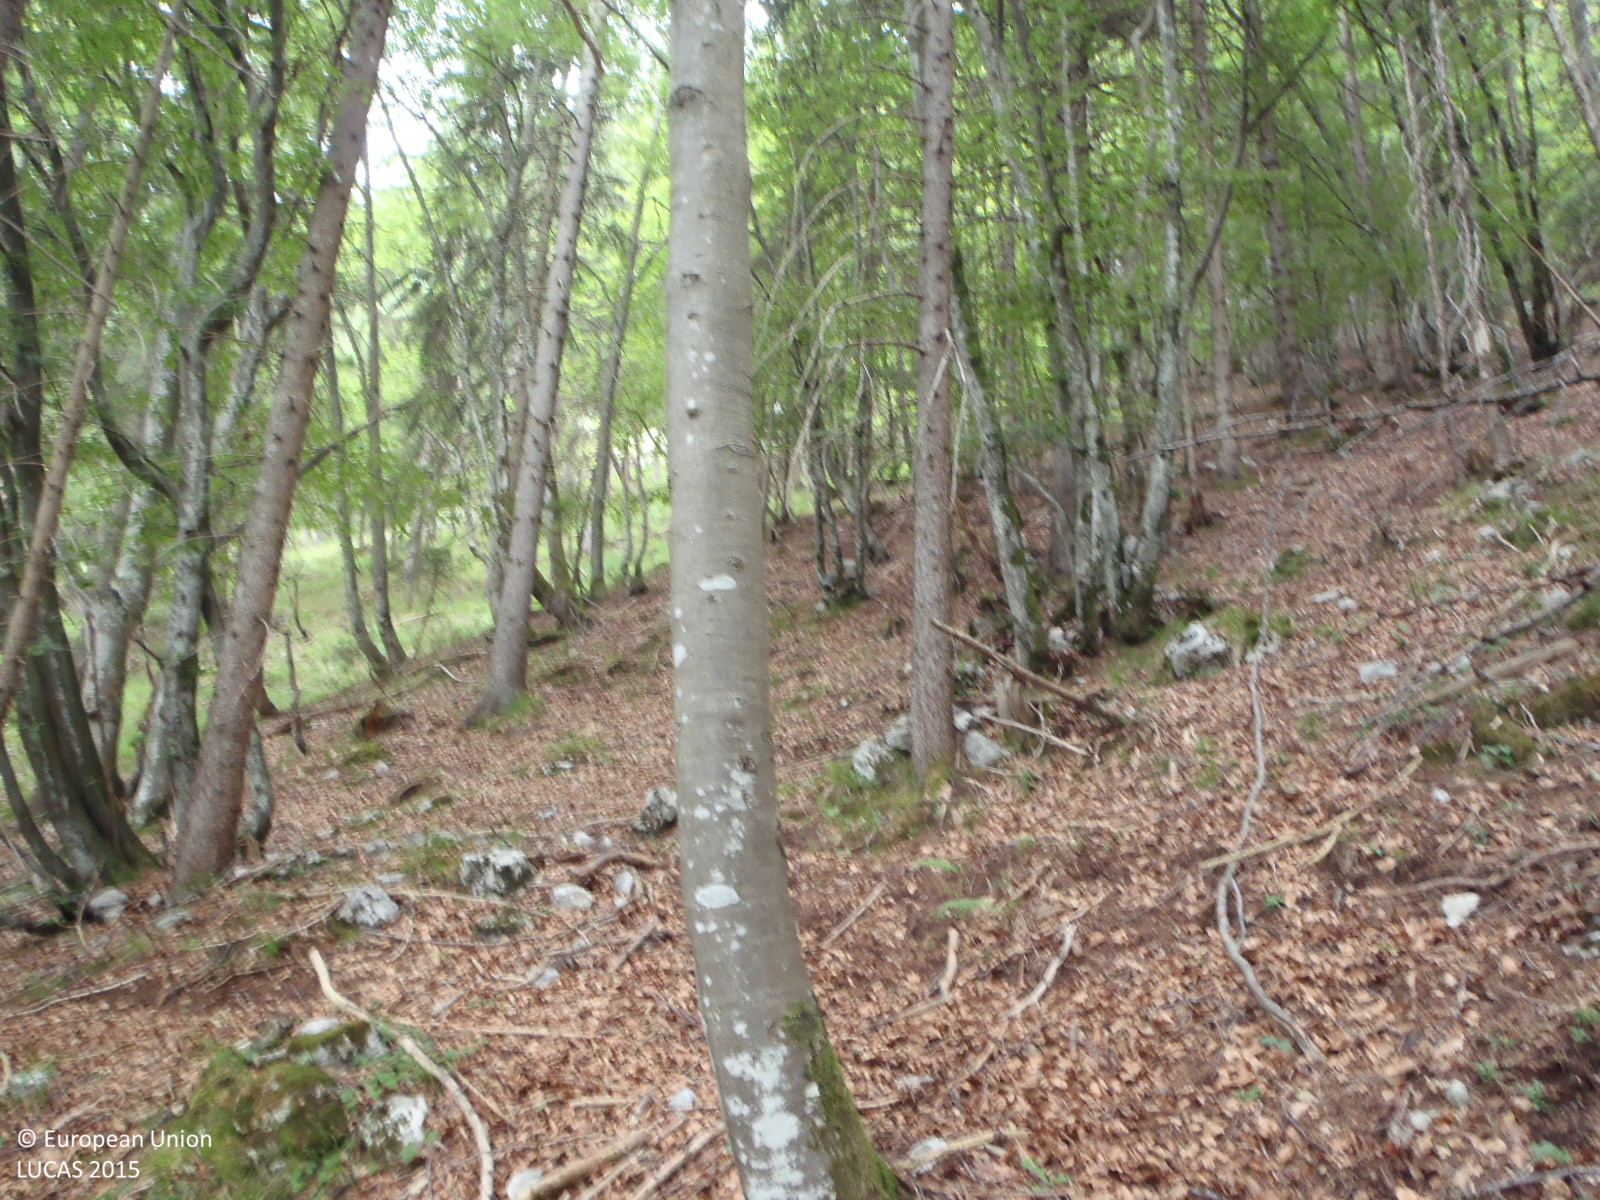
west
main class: Woodland
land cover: Spruce dominated mixed woodland
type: alpine coniferous forest
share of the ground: > 75 %
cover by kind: coniferous forest trees 45 %, broadleaved forest trees 45 %, unconsolidated bare surface 10 %
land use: Forestry
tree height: > 5 m
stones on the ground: < 10 %
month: July
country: AT
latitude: 47.4169
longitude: 11.7879
